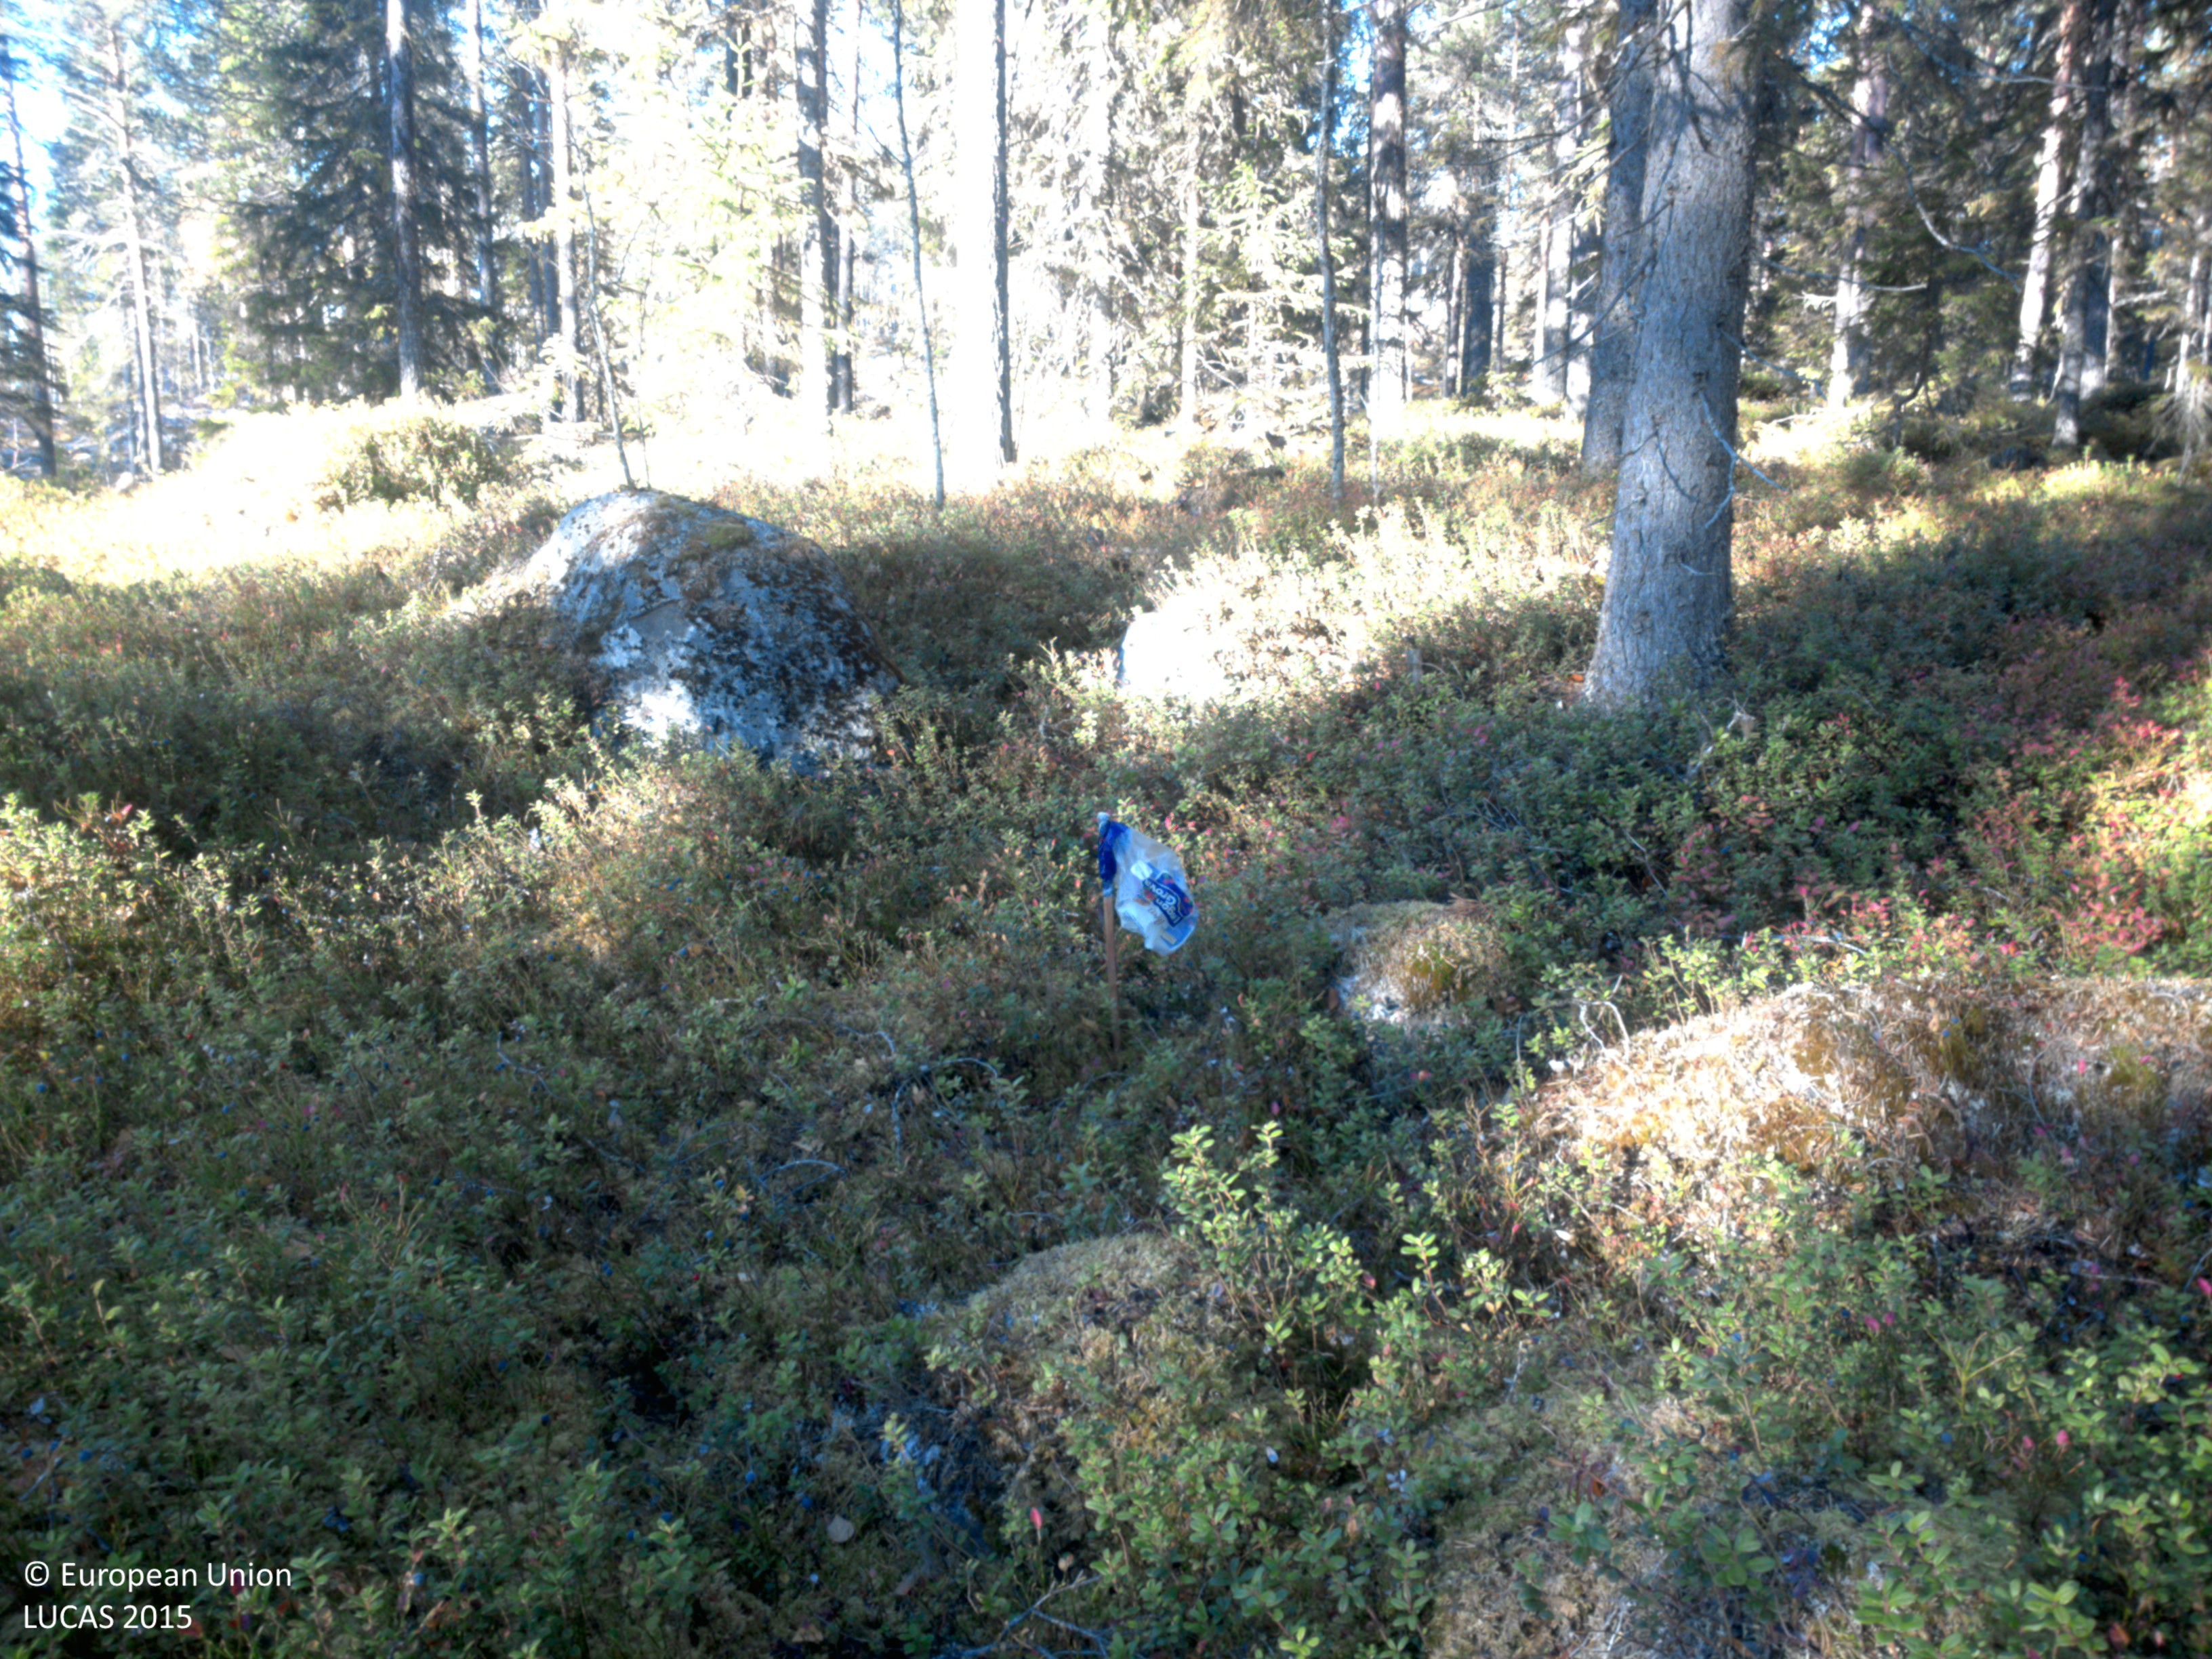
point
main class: Woodland
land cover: Other coniferous woodland
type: boreal forest
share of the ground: 50 - 75 %
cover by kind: coniferous forest trees 65 %, shrubs 20 %, lichens and mosses 10 %, herbaceous plants 5 %
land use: Forestry
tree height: > 5 m
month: October
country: SE
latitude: 64.7618
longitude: 18.3108
